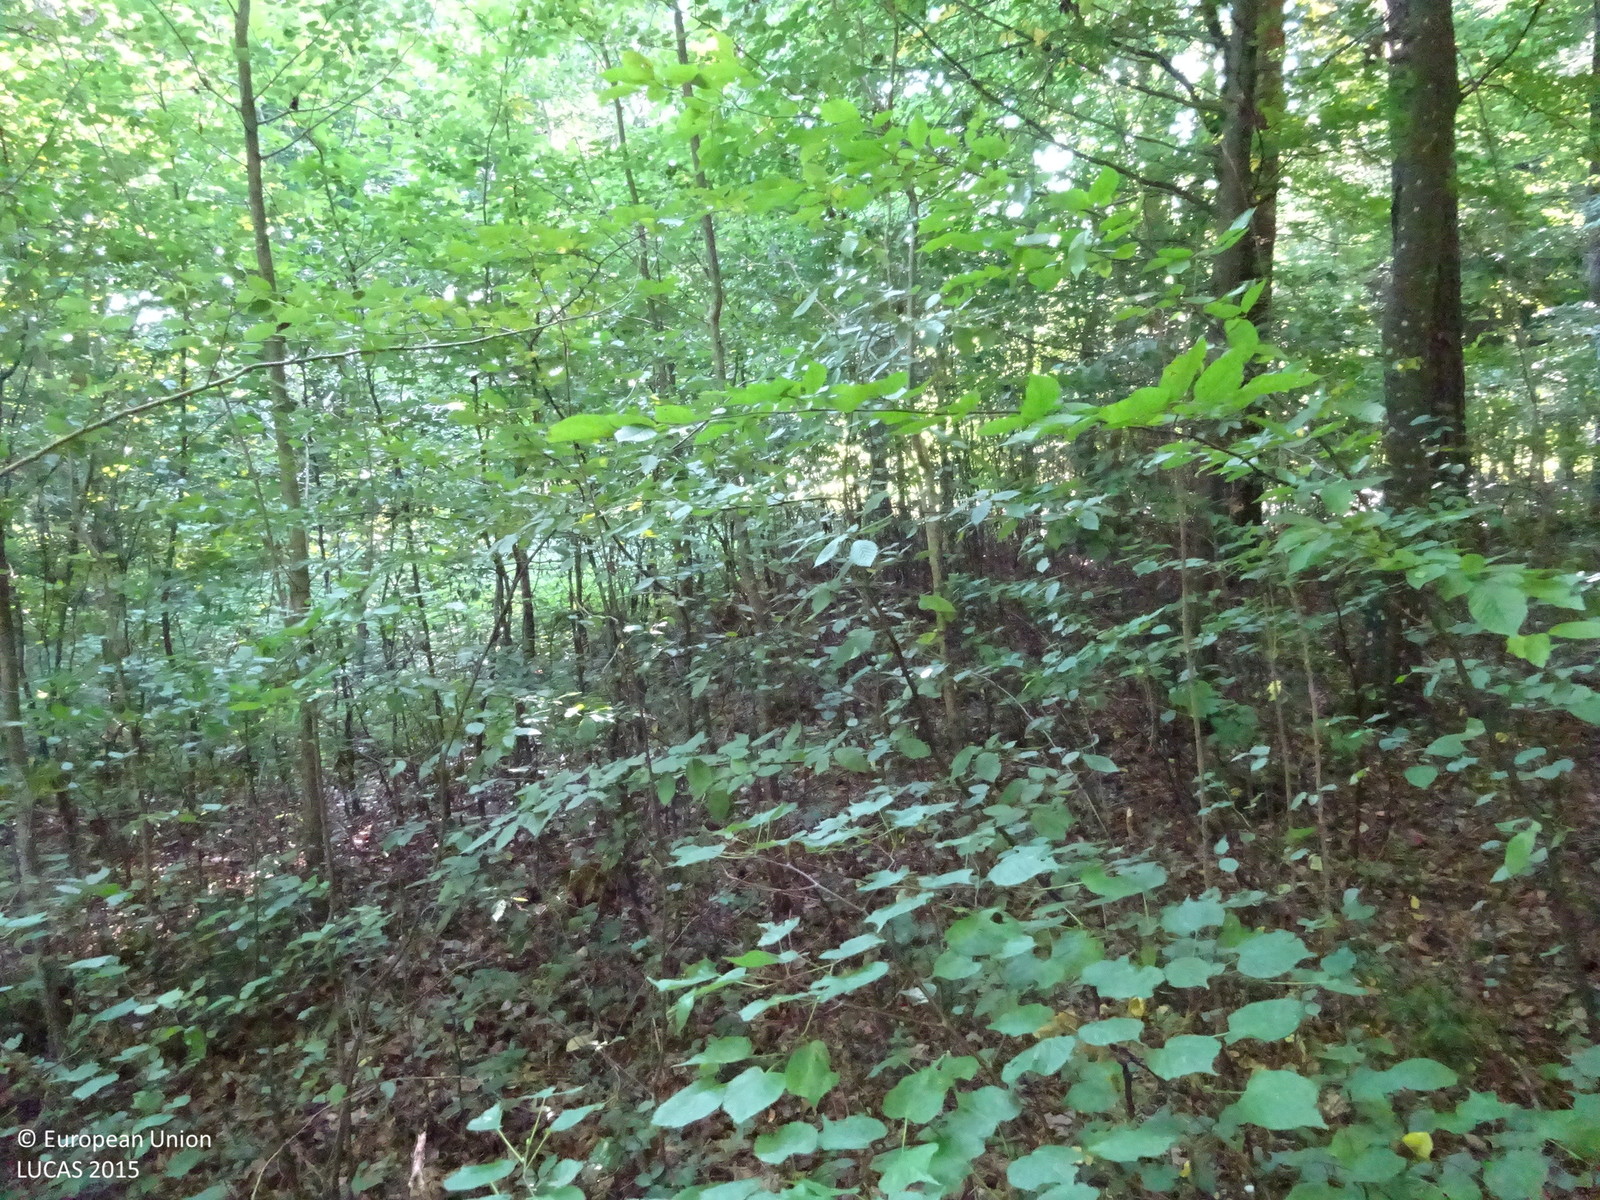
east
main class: Woodland
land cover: Broadleaved woodland
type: mesophytic deciduous forest
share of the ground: > 75 %
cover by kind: broadleaved forest trees 90 %, coniferous forest trees 10 %
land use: Forestry
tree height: > 5 m
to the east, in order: Broadleaved woodland; Tracks; Broadleaved woodland; Spruce dominated coniferous woodland; Broadleaved woodland; Grassland with sparse tree/shrub cover; Apple fruit; Artificial constructions in urban areas; Grassland with sparse tree/shrub cover; Spontaneously vegetated surfaces
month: August
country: AT
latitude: 47.3743
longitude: 16.0013
